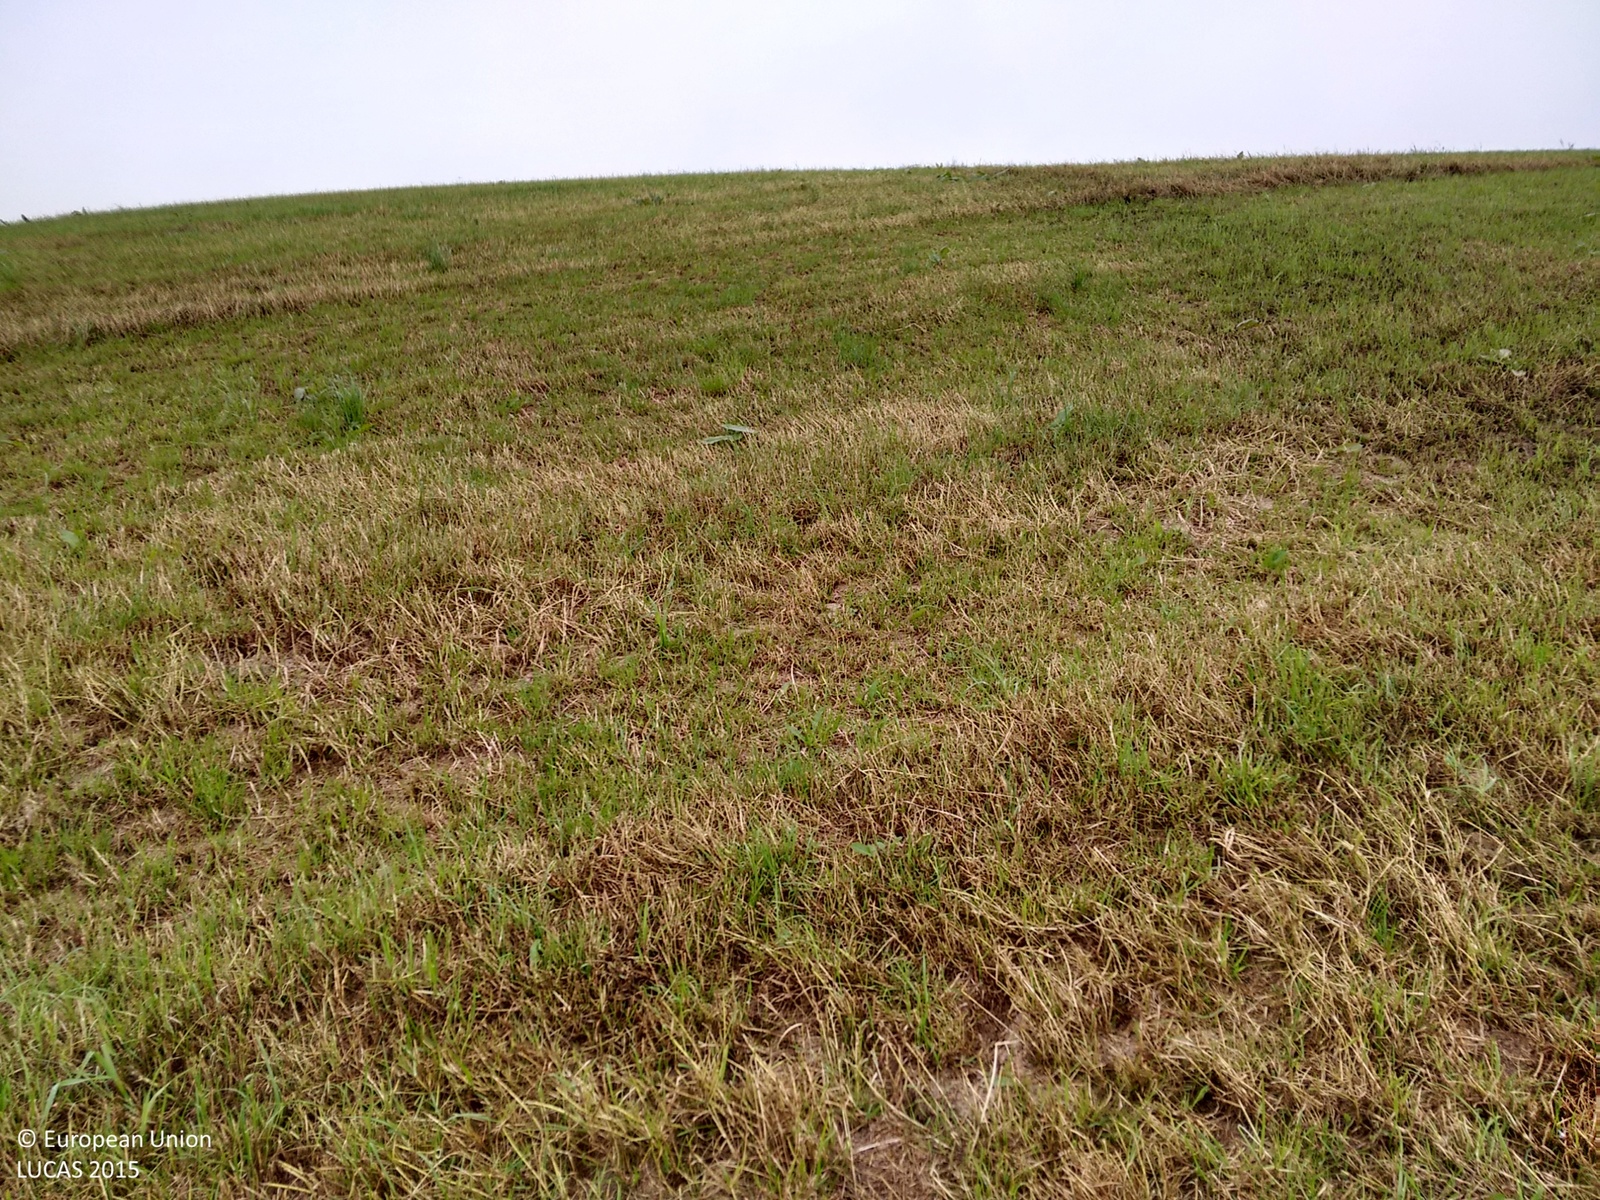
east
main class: Grassland
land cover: Grassland without tree/shrub cover
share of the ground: 25 - 50 %
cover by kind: herbaceous plants 50 %, unconsolidated bare surface 50 %
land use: Agriculture (excluding fallow land and kitchen gardens)
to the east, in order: Grassland without tree/shrub cover; Fences; Dry stone walls; Broadleaved woodland
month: June
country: GB
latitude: 55.0656
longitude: -3.6915
